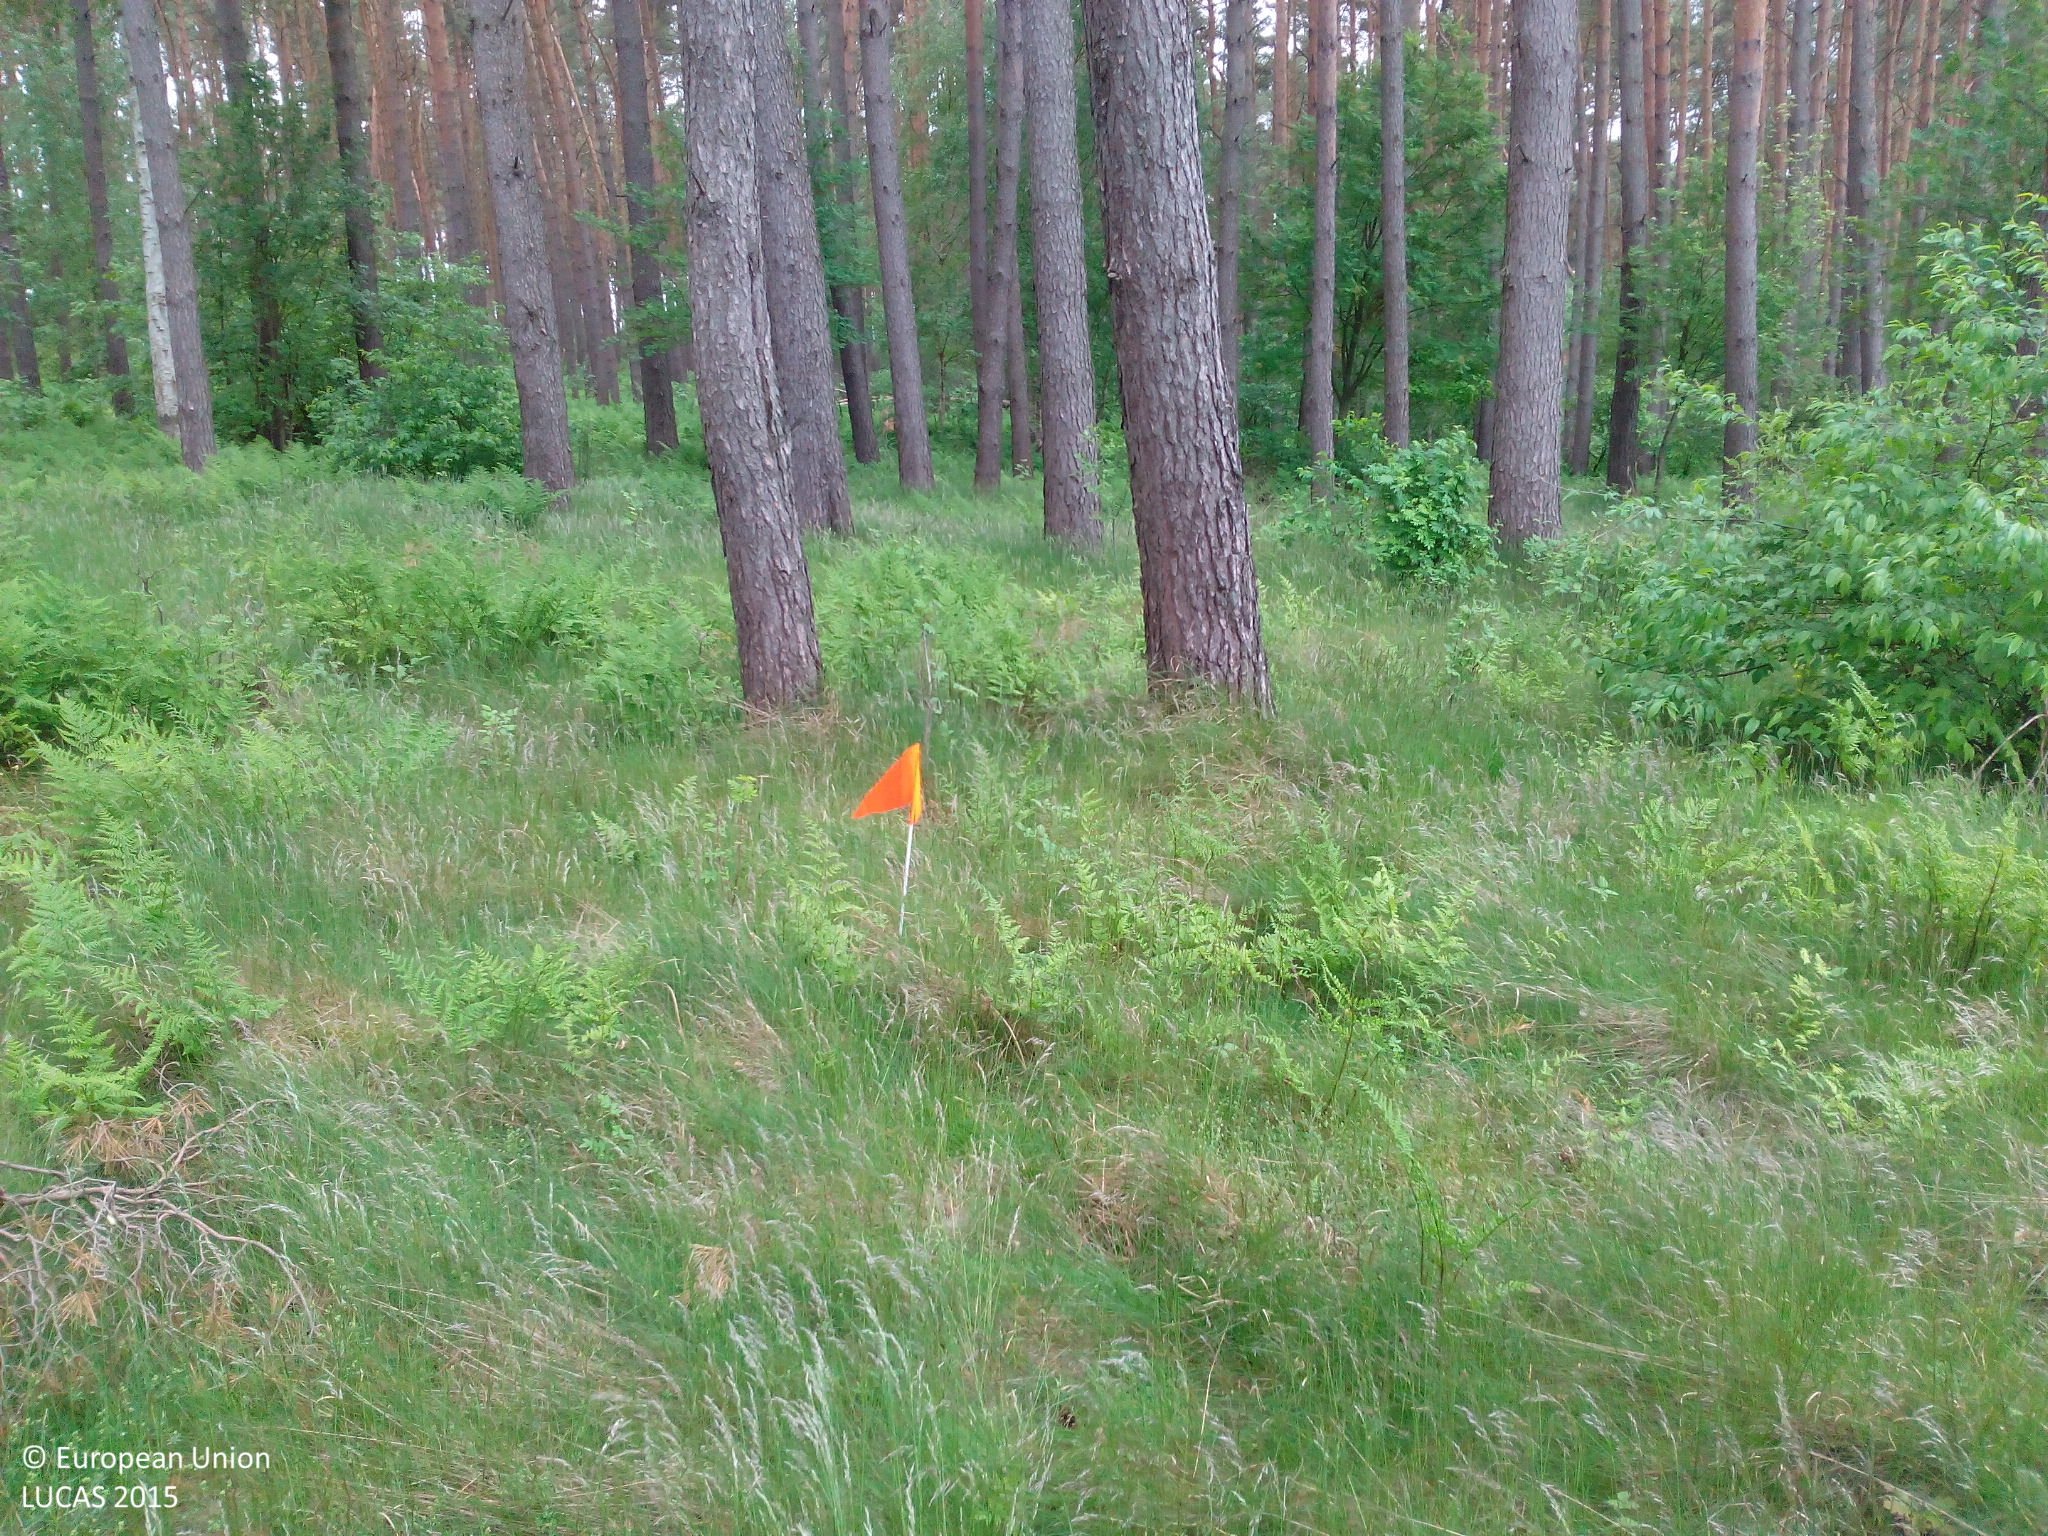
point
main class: Woodland
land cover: Pine dominated coniferous woodland
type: hemiboreal forest and nemoral coniferous forest and mixed broadleaved-coniferous forest
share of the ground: > 75 %
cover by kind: coniferous forest trees 85 %, herbaceous plants 10 %, shrubs 5 %
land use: Forestry
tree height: > 5 m
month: June
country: DE
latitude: 53.3010
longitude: 11.6349
